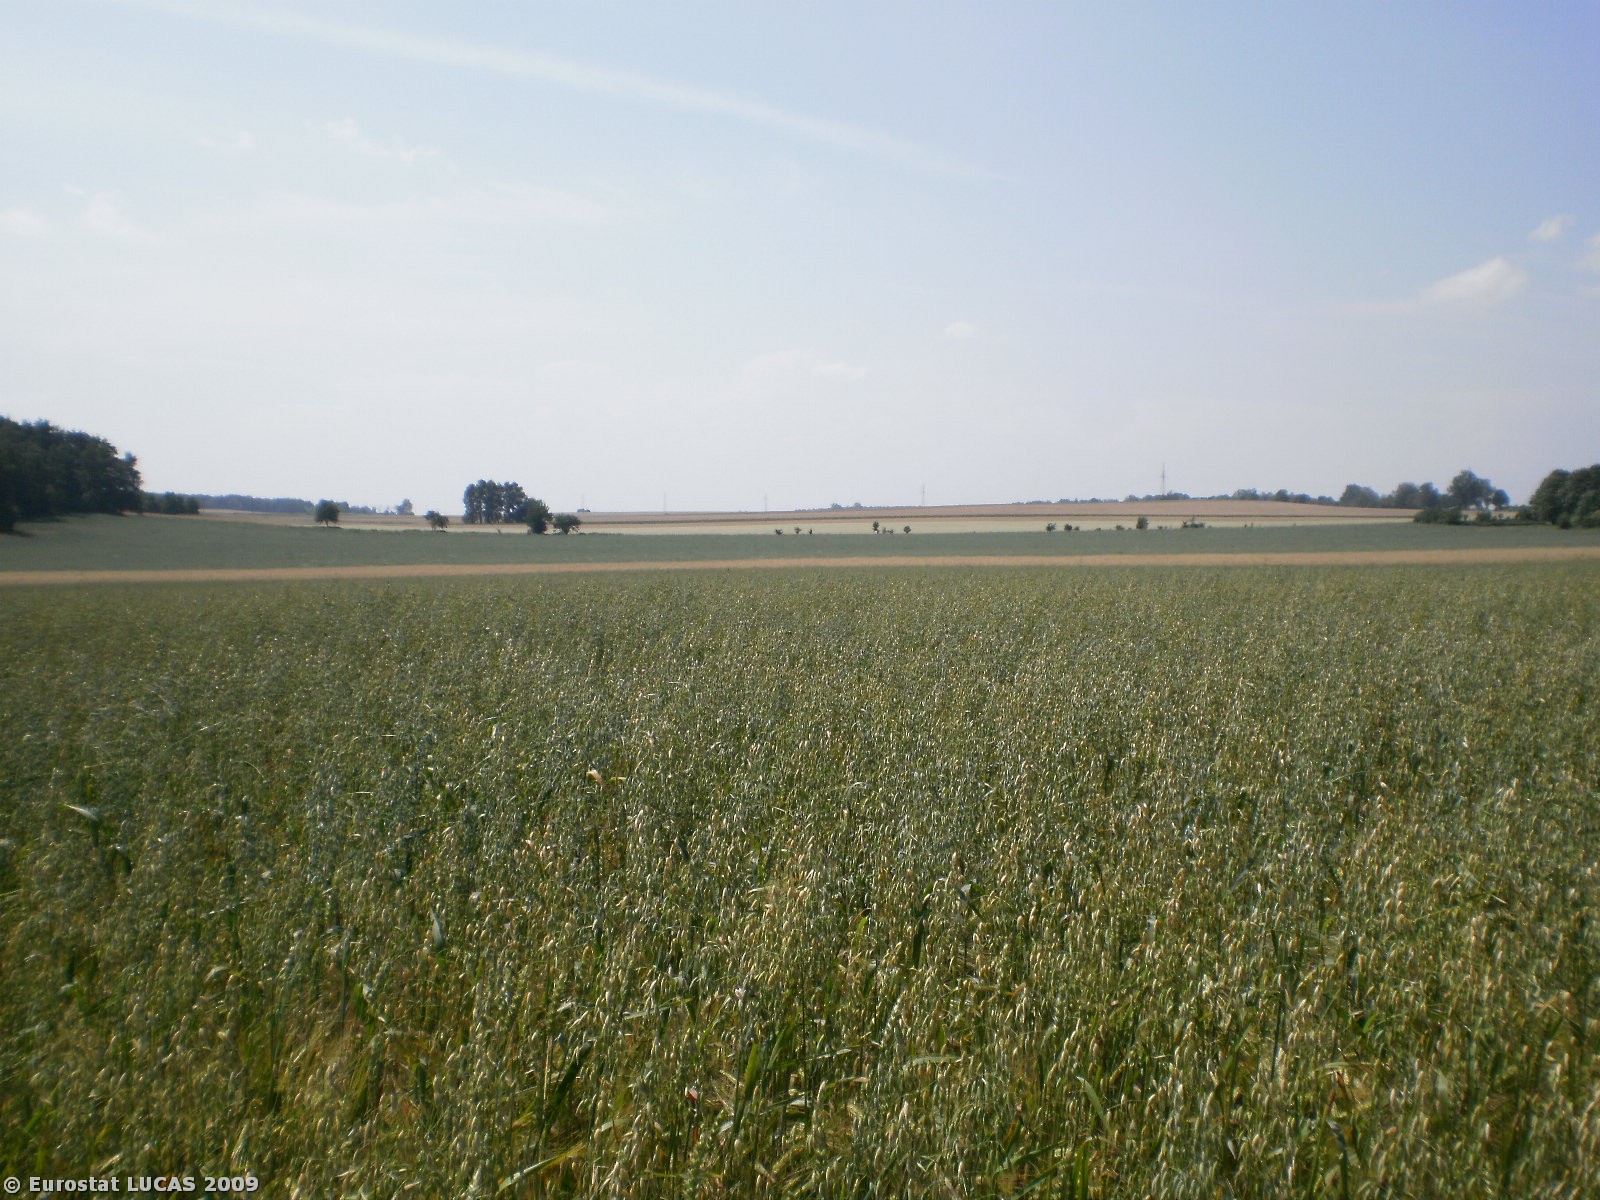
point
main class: Cropland
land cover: Mixed cereals for fodder
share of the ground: > 75 %
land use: Agriculture (excluding fallow land and kitchen gardens)
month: July
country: PL
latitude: 53.3529
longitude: 20.3873
